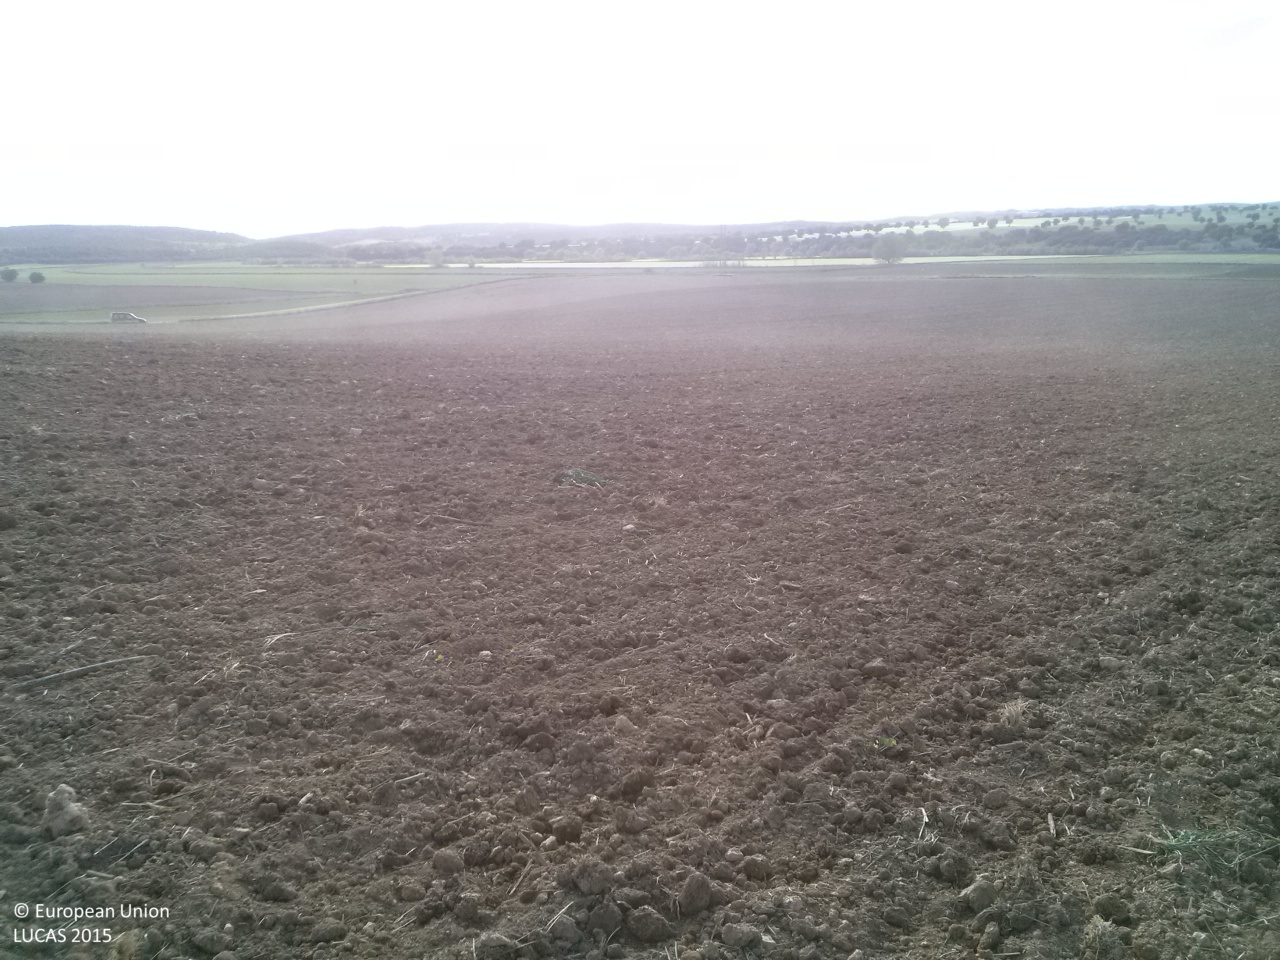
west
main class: Cropland
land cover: Sunflower
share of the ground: < 10 %
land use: Agriculture (excluding fallow land and kitchen gardens)
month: May
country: ES
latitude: 39.8915
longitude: -2.7316
